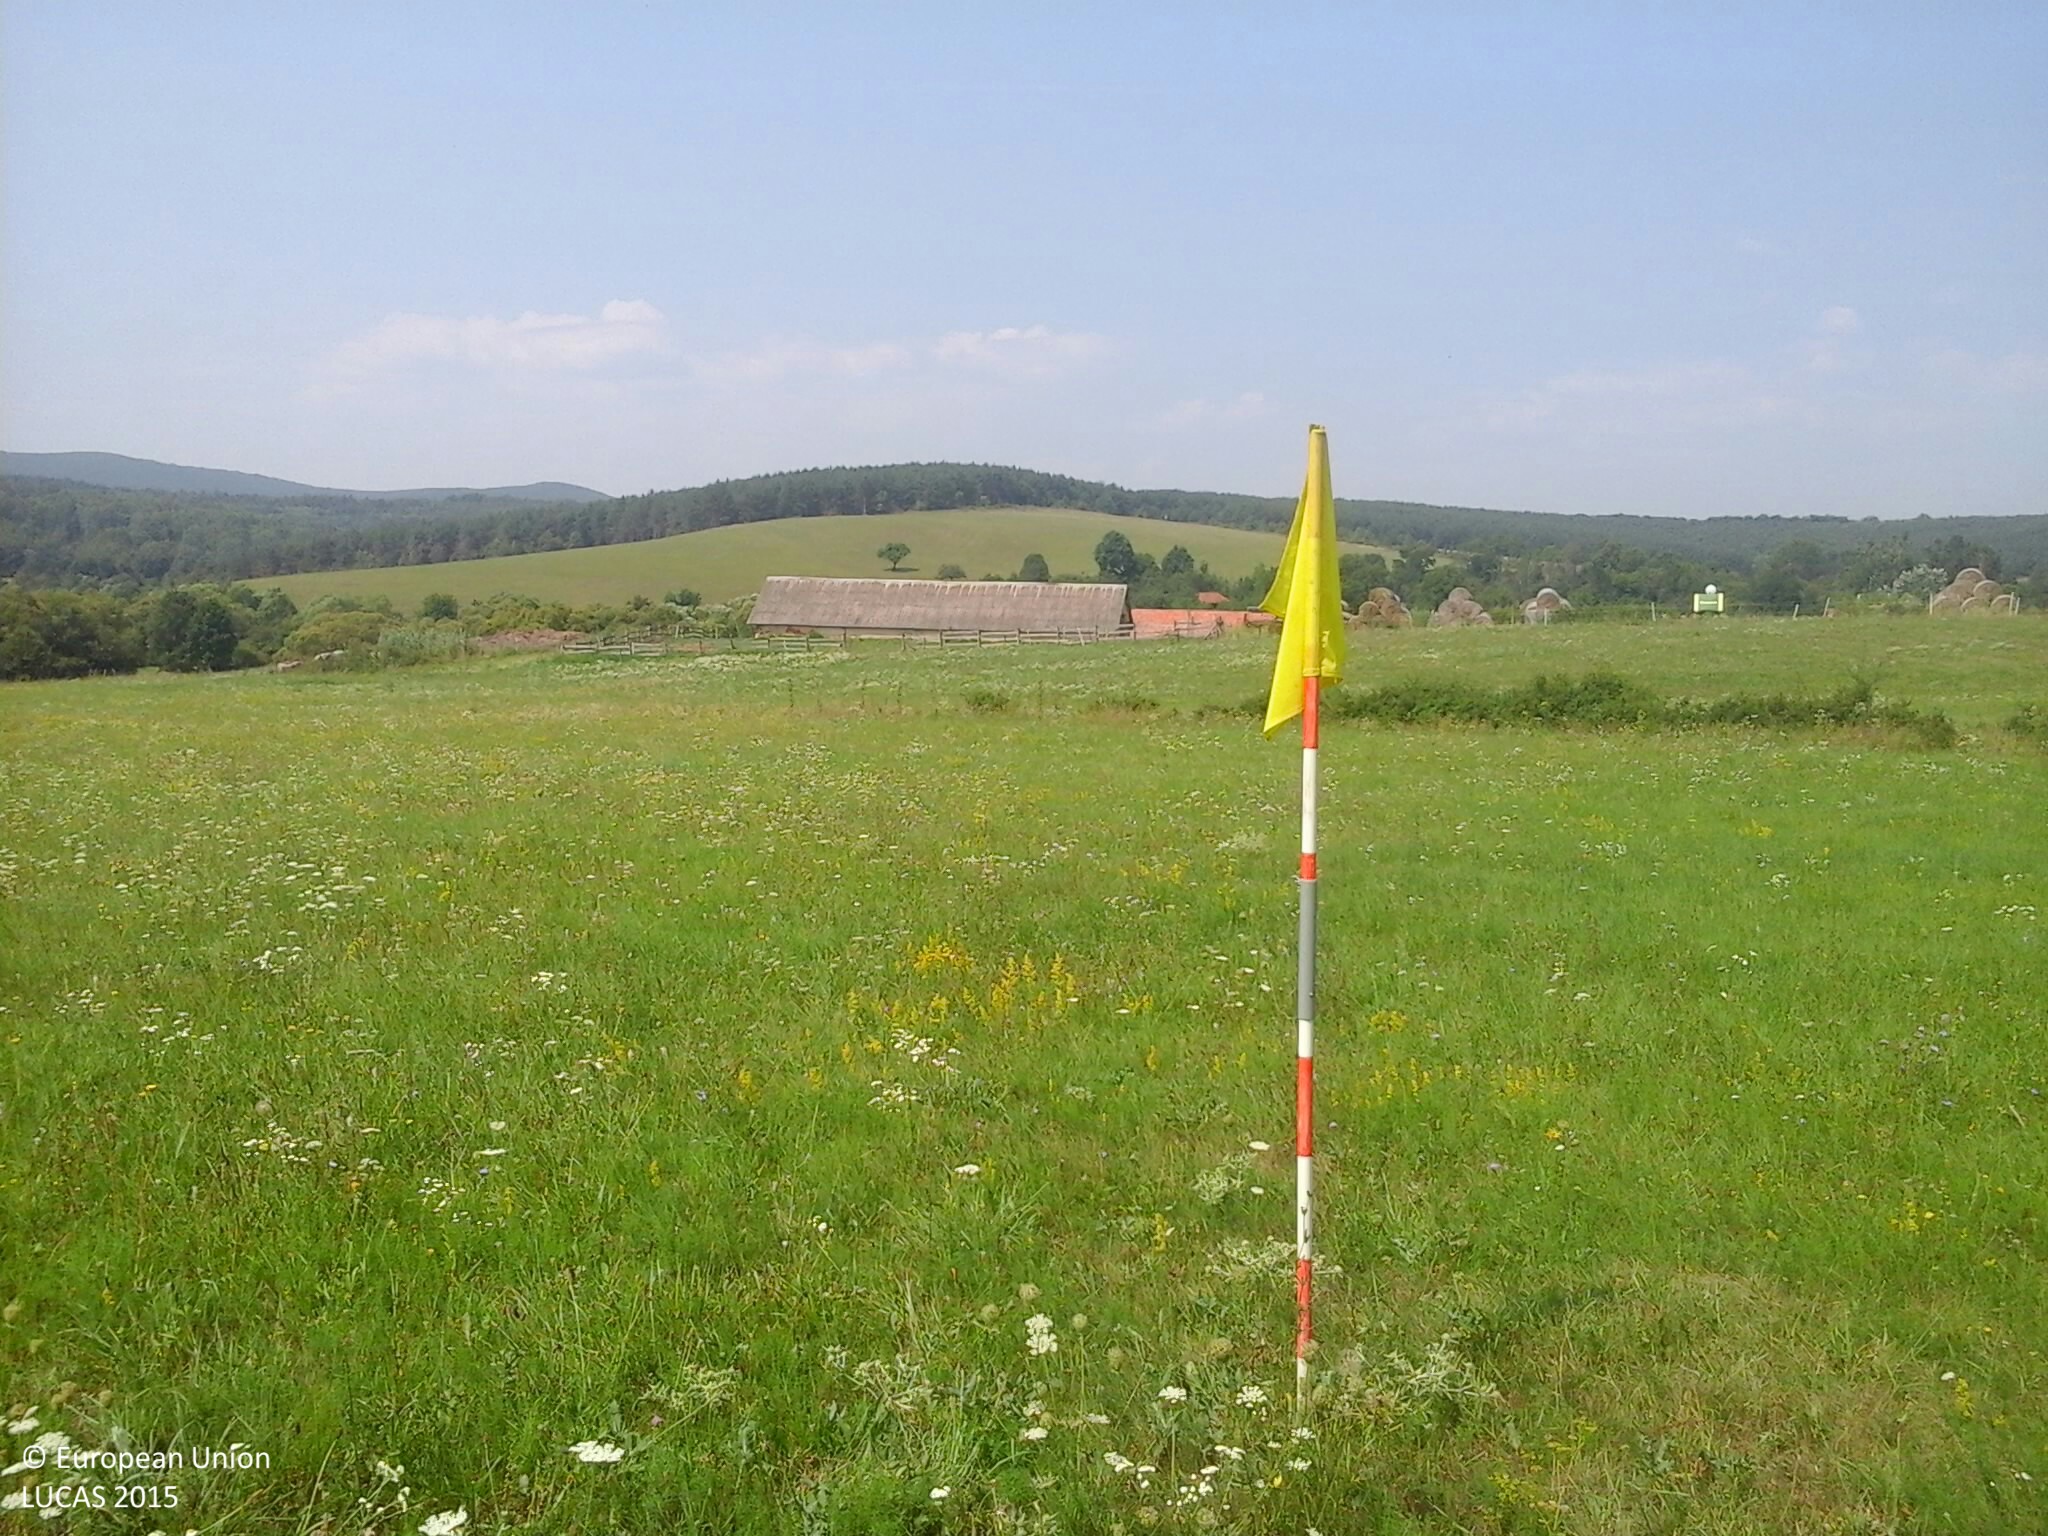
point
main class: Grassland
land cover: Grassland without tree/shrub cover
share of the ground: > 75 %
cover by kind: herbaceous plants 100 %
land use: Agriculture (excluding fallow land and kitchen gardens)
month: August
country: HU
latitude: 48.4878
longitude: 20.8223
